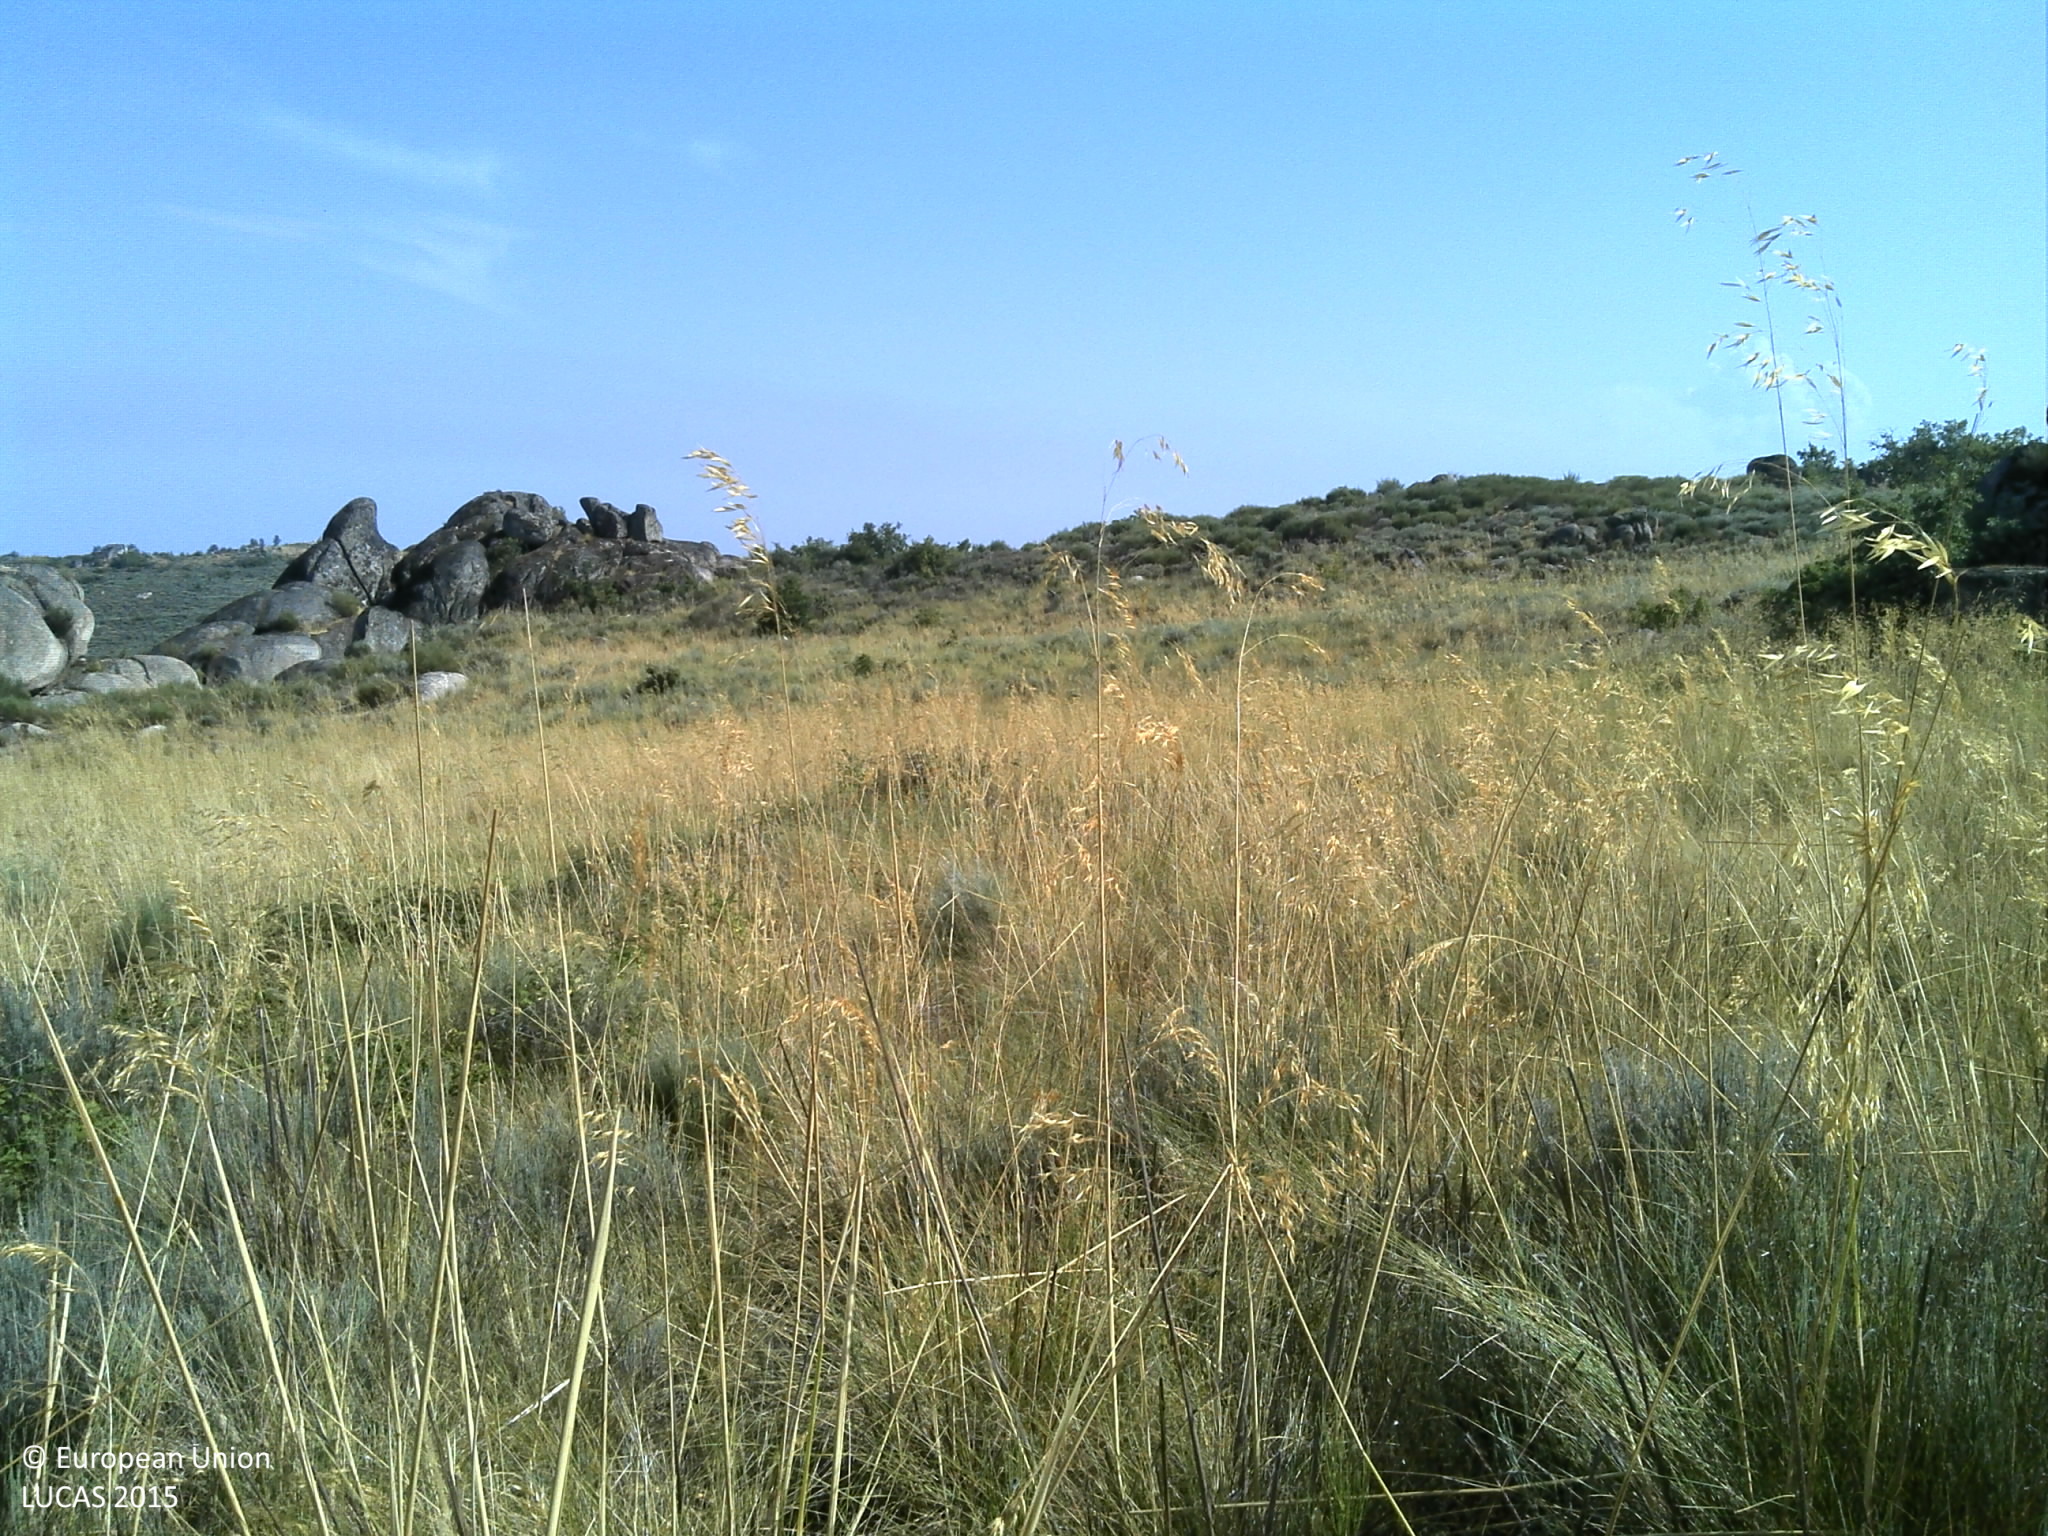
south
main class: Shrubland
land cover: Shrubland without tree cover
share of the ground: 25 - 50 %
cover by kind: shrubs 40 %, unconsolidated bare surface 30 %, consolidated bare surface 20 %, herbaceous plants 10 %
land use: Semi-natural and natural areas not in use
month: July
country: PT
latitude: 40.8744
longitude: -7.3061
